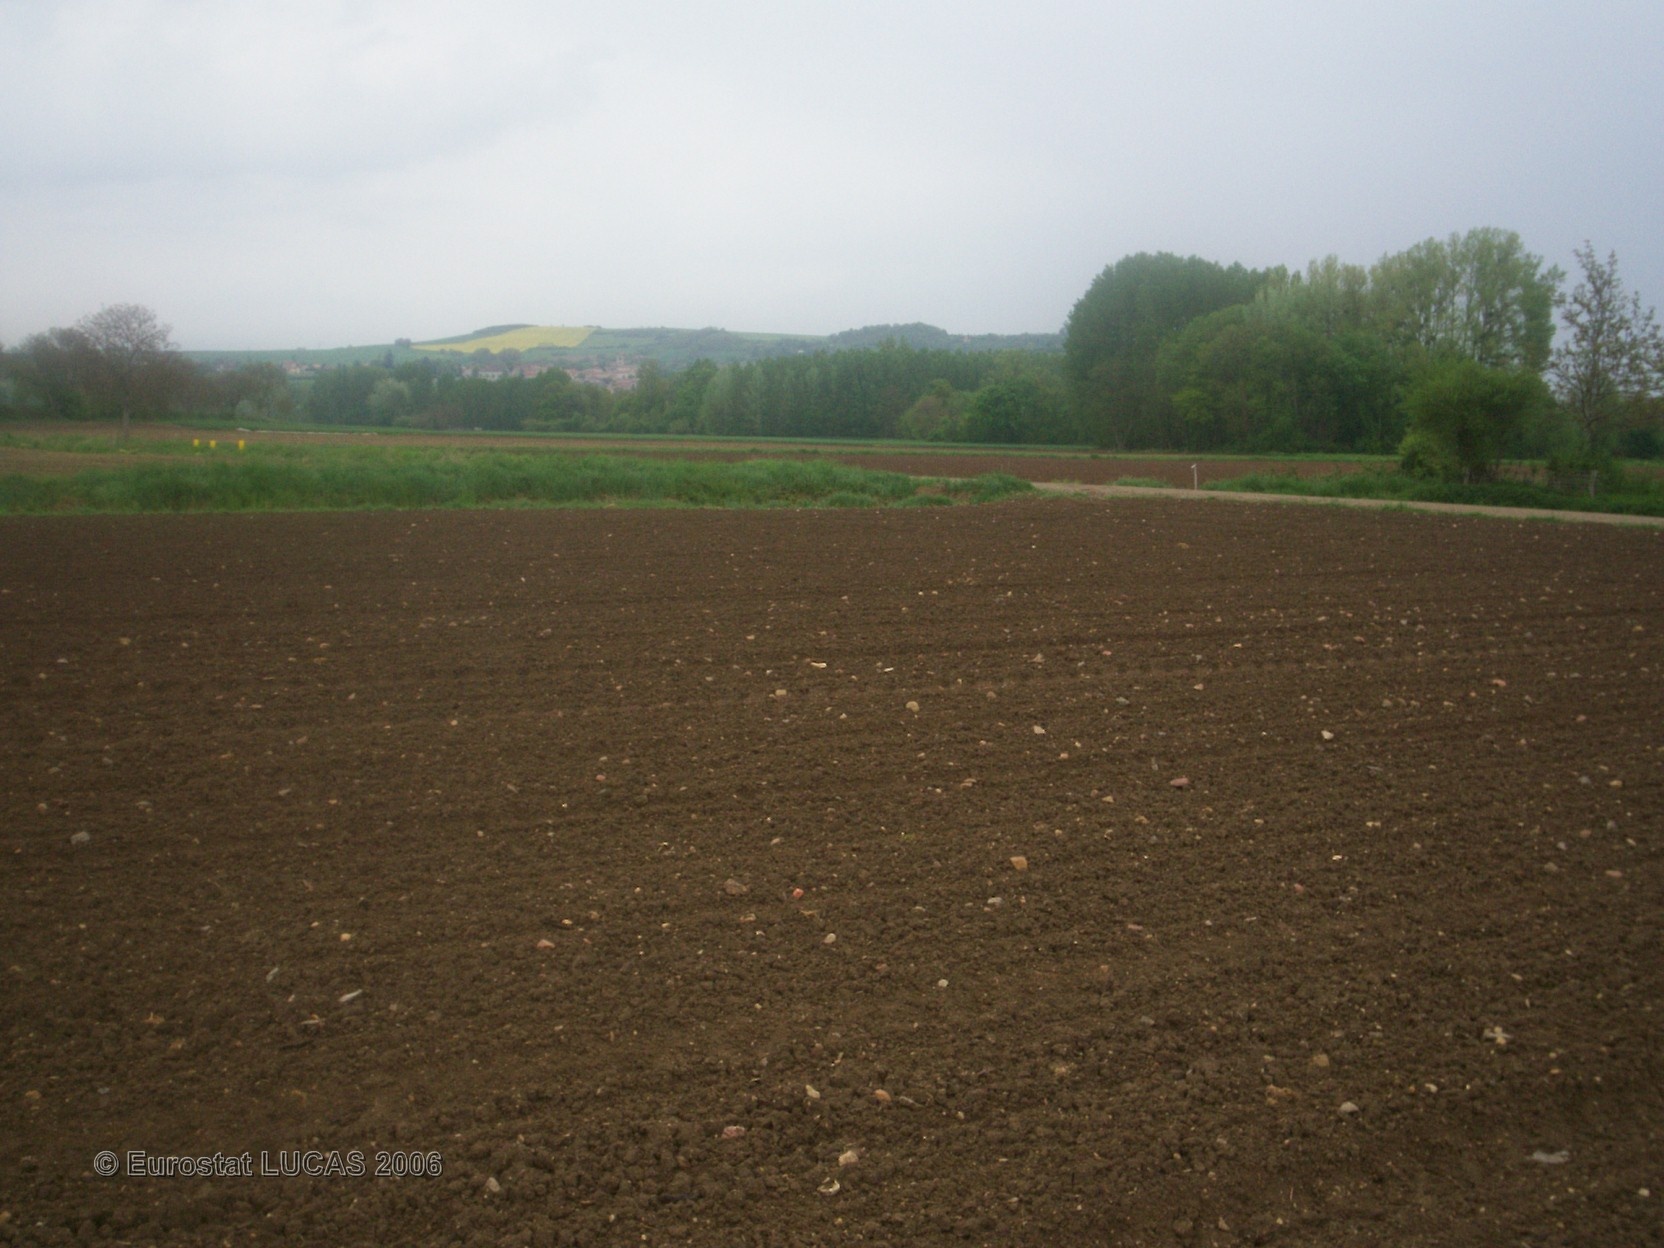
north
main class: Cropland
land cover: Maize
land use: Agriculture (excluding fallow land and kitchen gardens)
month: May
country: FR
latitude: 45.9866
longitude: 3.1444
